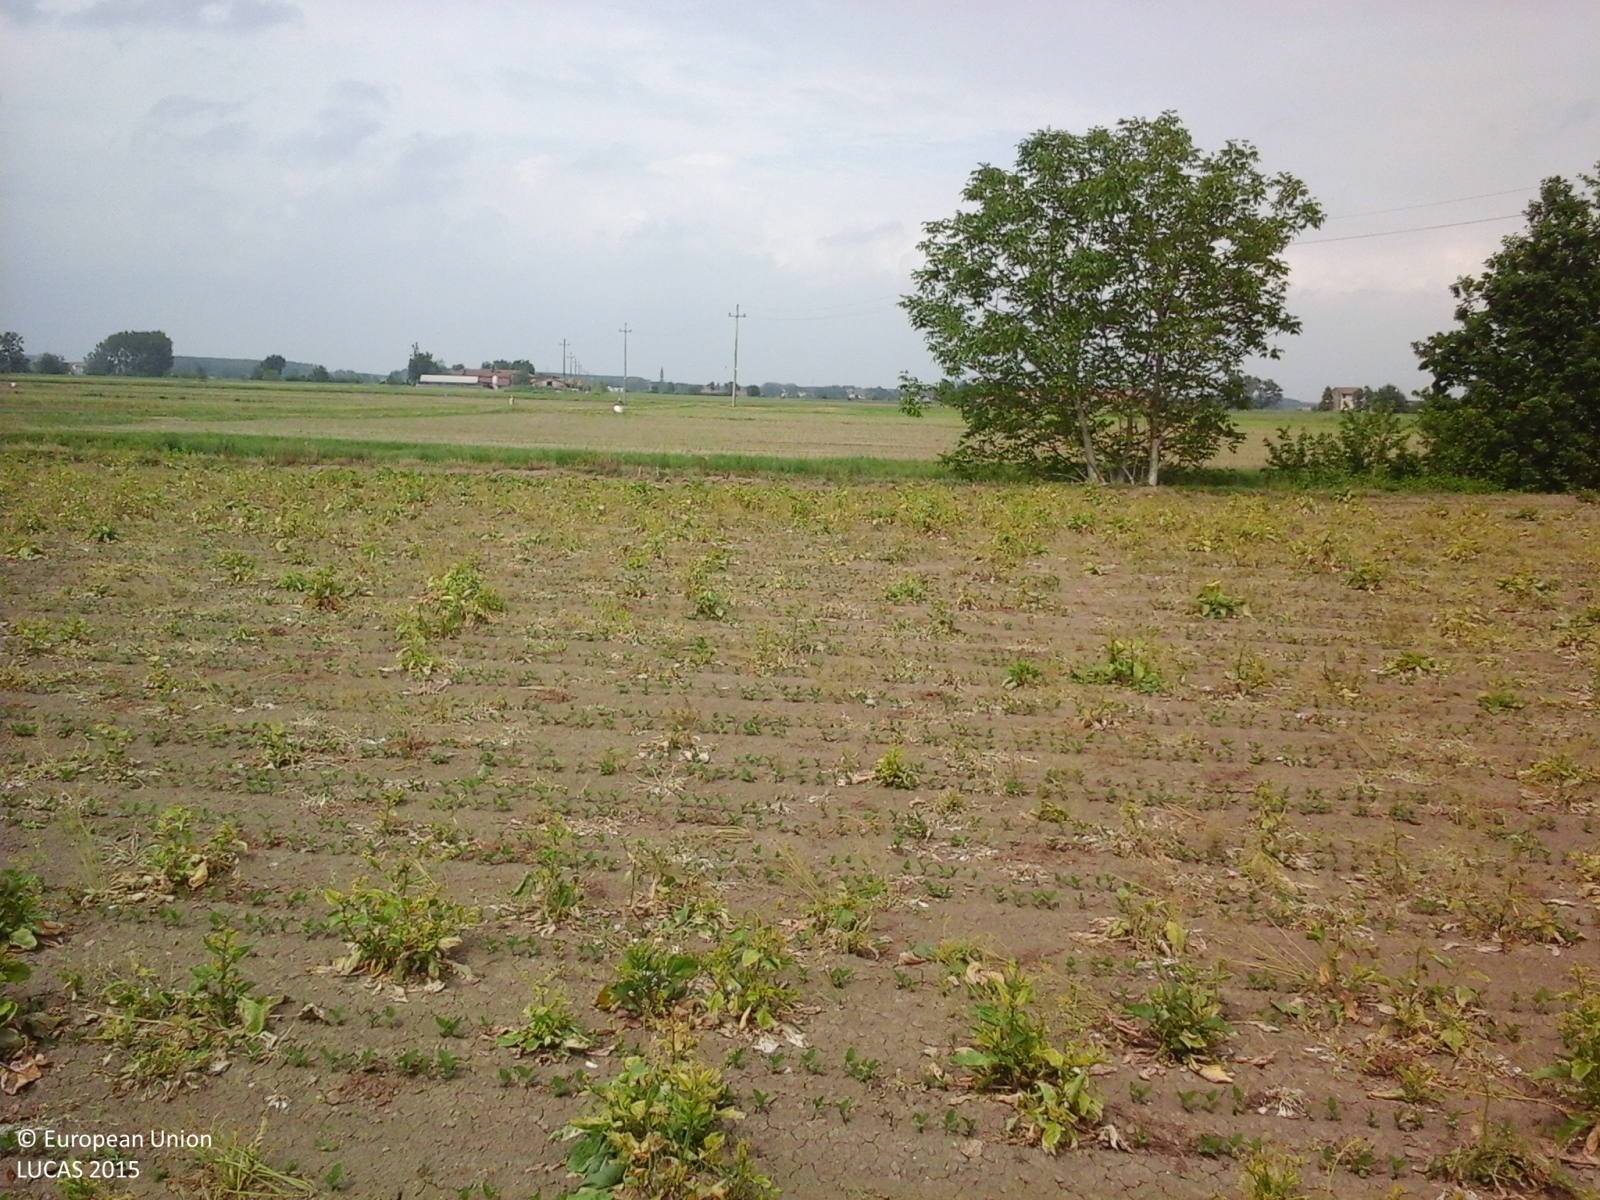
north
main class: Cropland
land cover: Soya
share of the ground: 10 - 25 %
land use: Agriculture (excluding fallow land and kitchen gardens)
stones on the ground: < 10 %
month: May
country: IT
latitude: 44.9979
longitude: 10.6204
